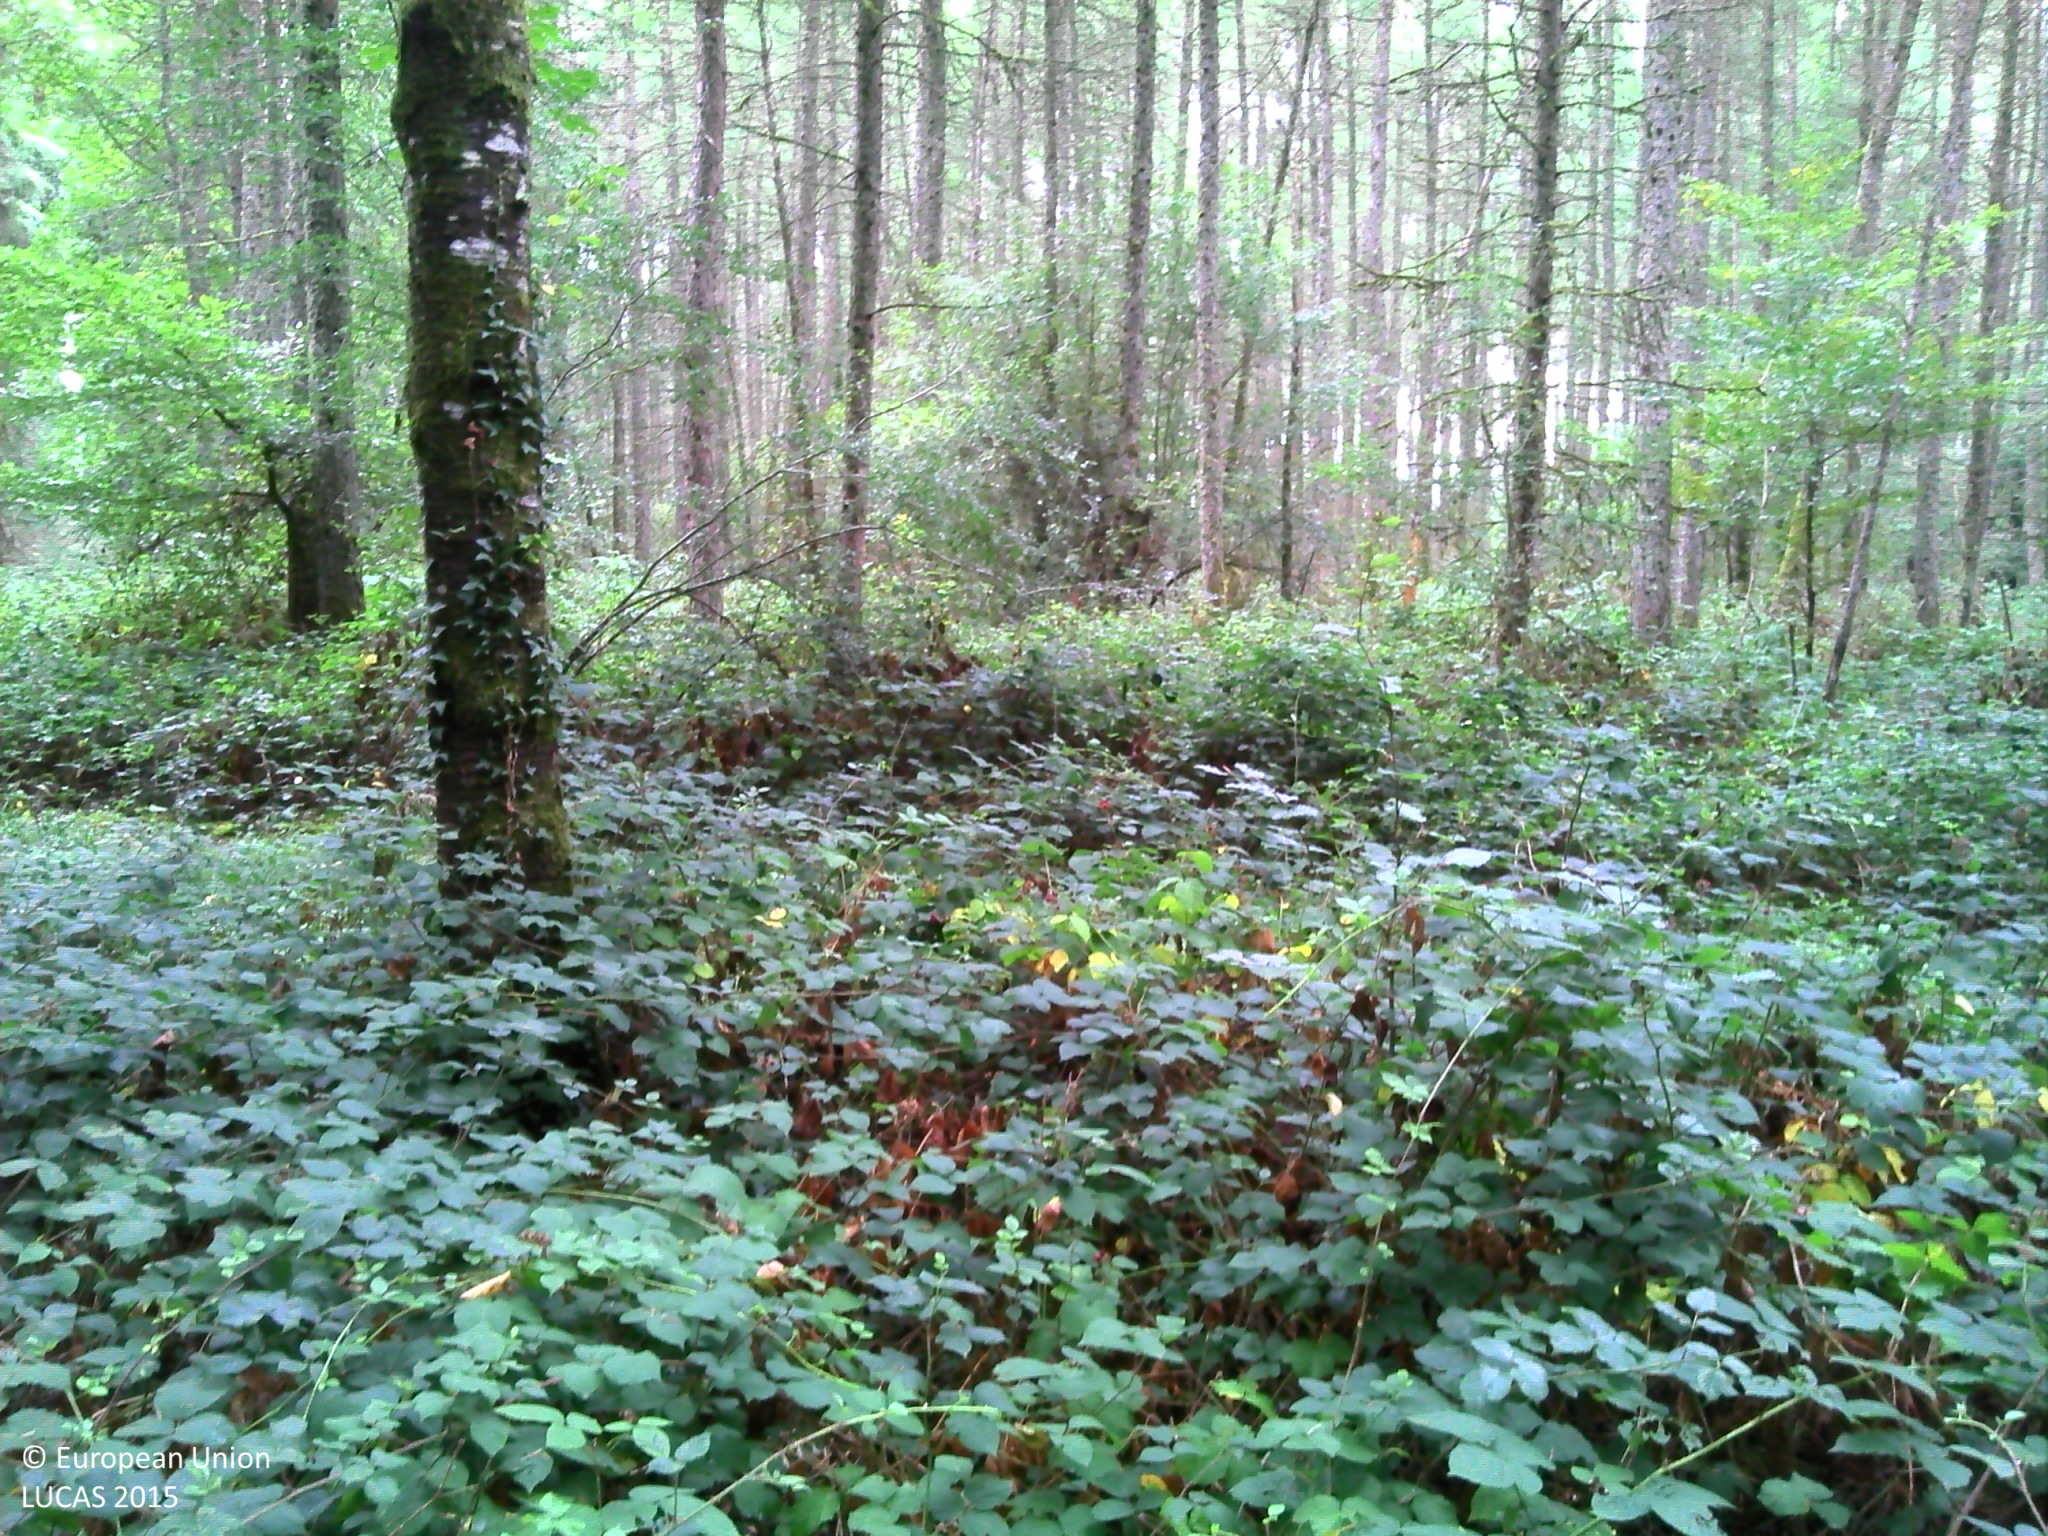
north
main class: Woodland
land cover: Other coniferous woodland
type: exotic forest
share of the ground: > 75 %
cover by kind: coniferous forest trees 90 %, herbaceous plants 5 %, lichens and mosses 5 %
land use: Forestry
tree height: > 5 m
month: September
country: FR
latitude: 47.7749
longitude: 4.4068
